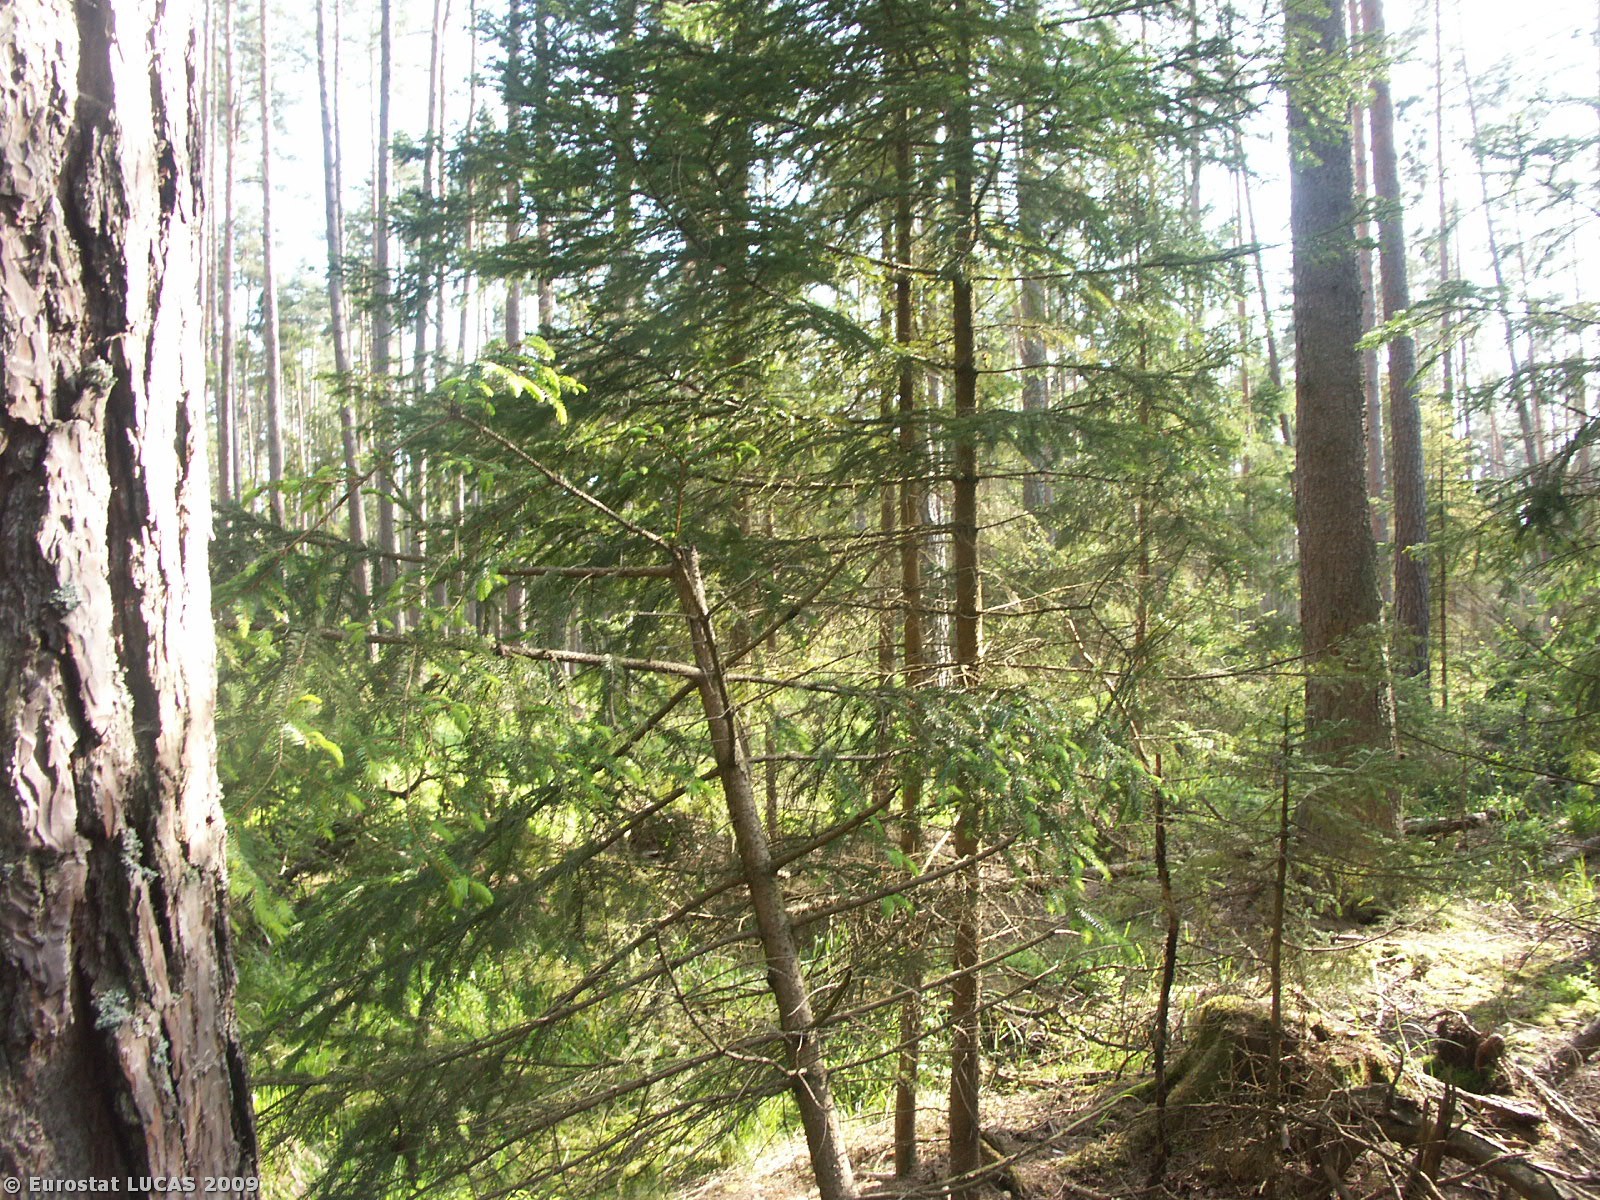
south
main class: Woodland
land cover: Coniferous woodland
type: hemiboreal forest and nemoral coniferous forest and mixed broadleaved-coniferous forest
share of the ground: > 75 %
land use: Forestry
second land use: Nature reserves
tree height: > 5 m
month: May
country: CZ
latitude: 49.0560
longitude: 14.8049
